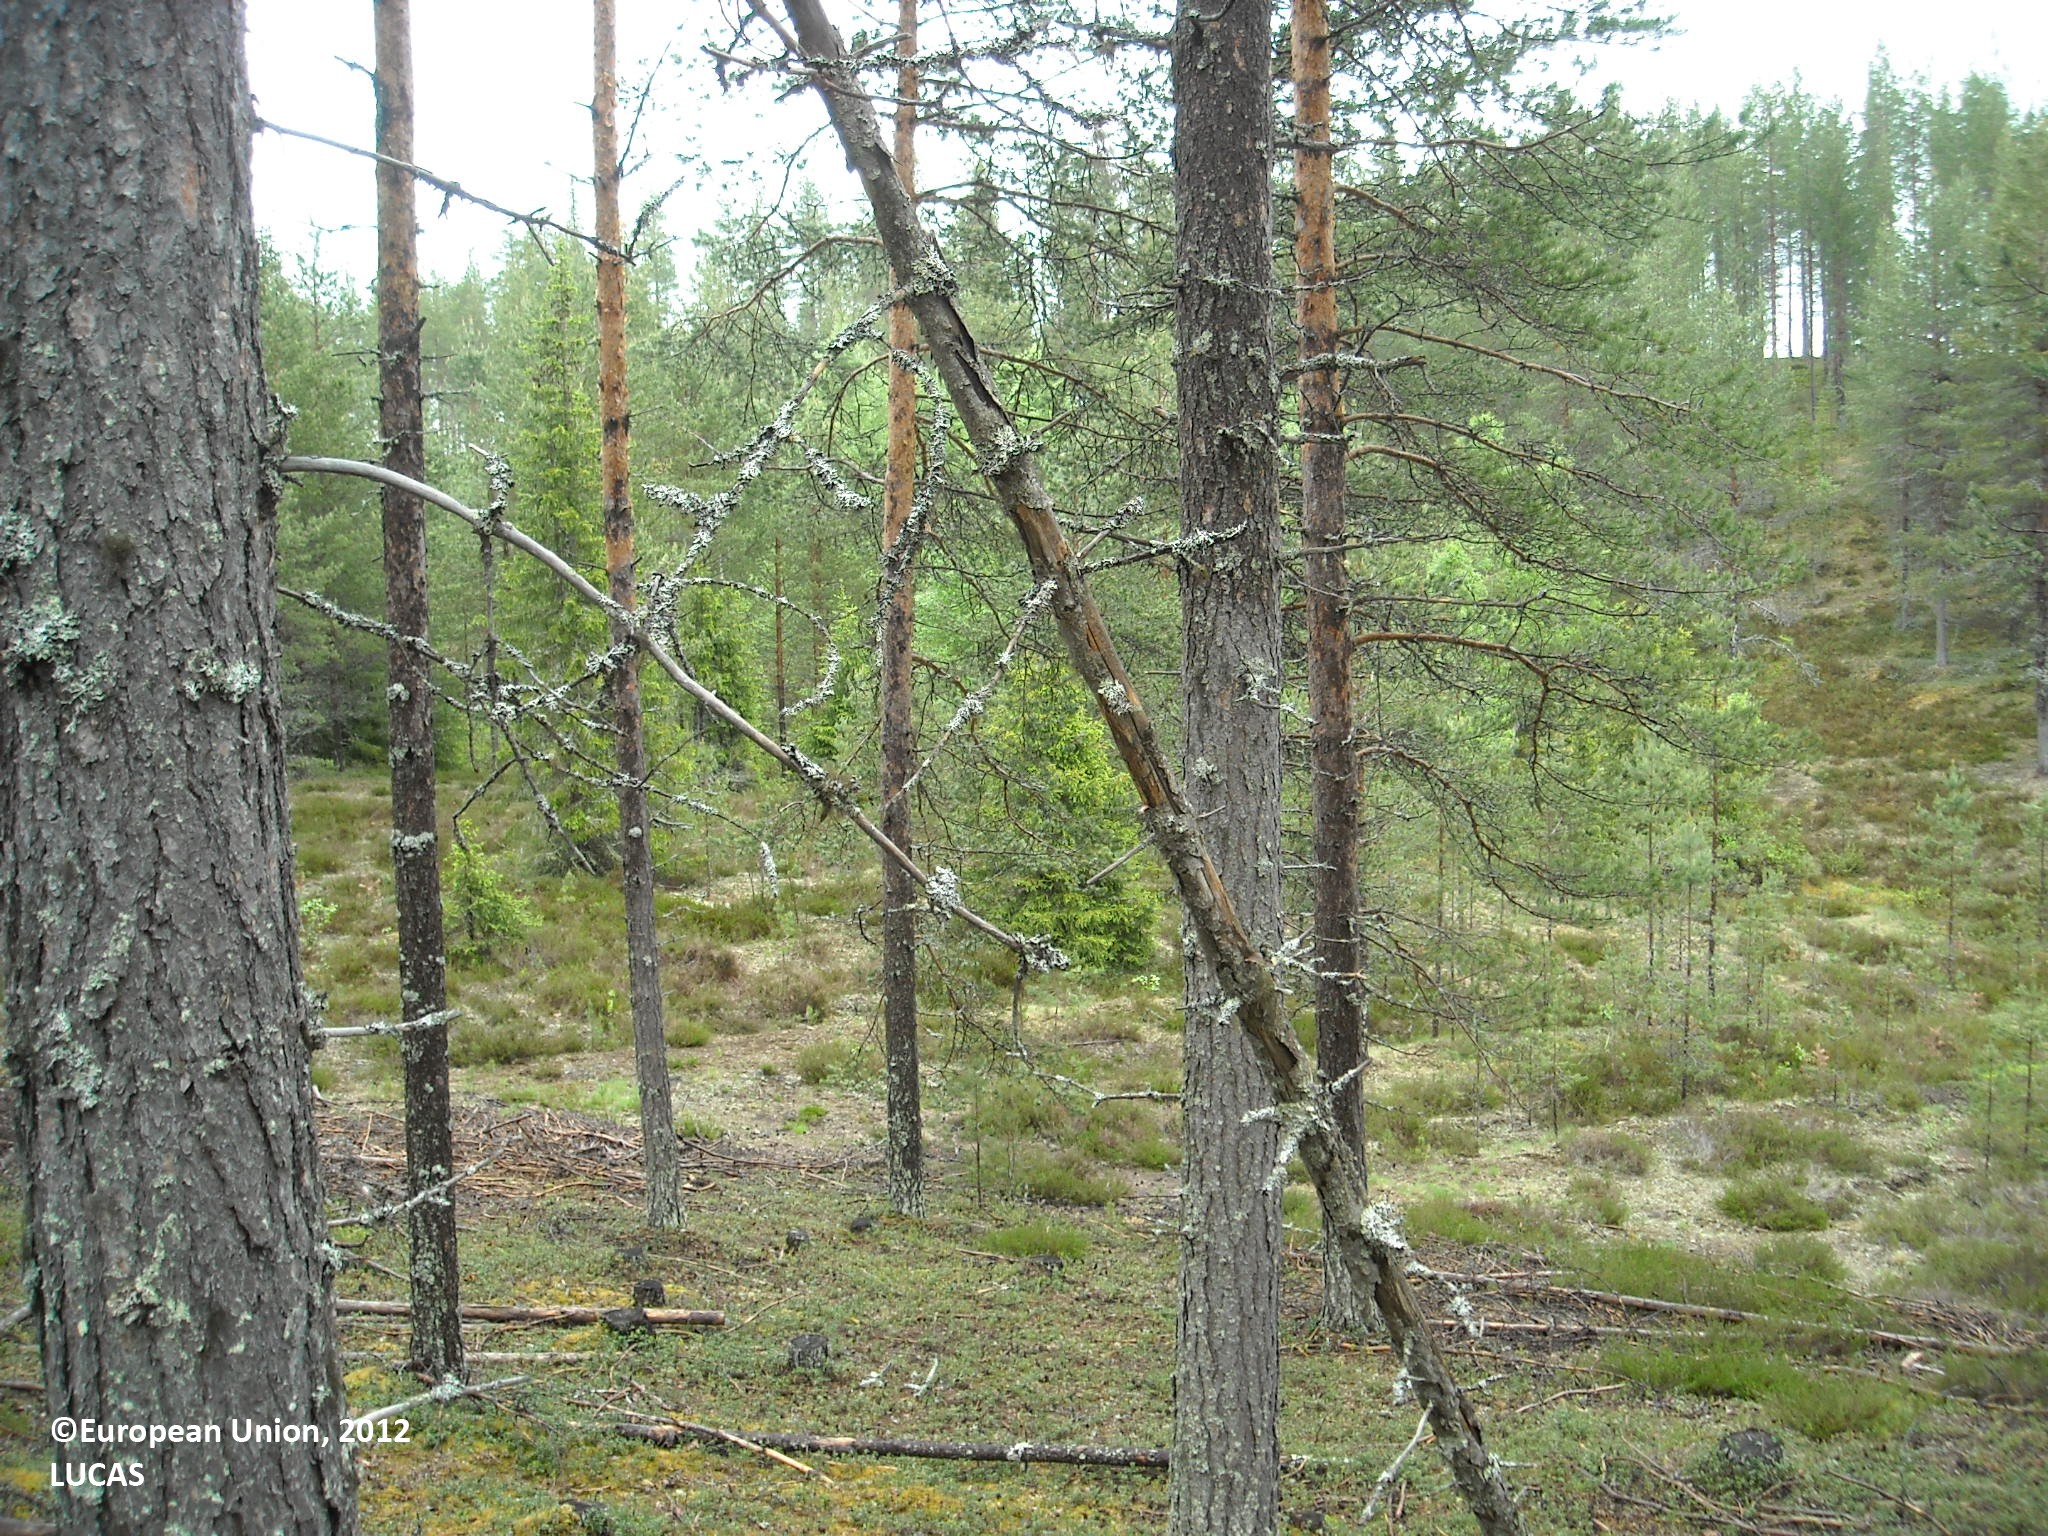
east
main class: Woodland
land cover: Pine dominated coniferous woodland
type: boreal forest
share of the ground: 50 - 75 %
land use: Forestry
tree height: > 5 m
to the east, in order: Pine dominated coniferous woodland; Other coniferous woodland; Pine dominated coniferous woodland; Other coniferous woodland; Grass margins; Paved roads, cycling and walking lanes; Grass margins; Abandoned hedges; Paved roads, cycling and walking lanes; Grass margins
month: June
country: FI
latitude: 65.5075
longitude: 27.9338
